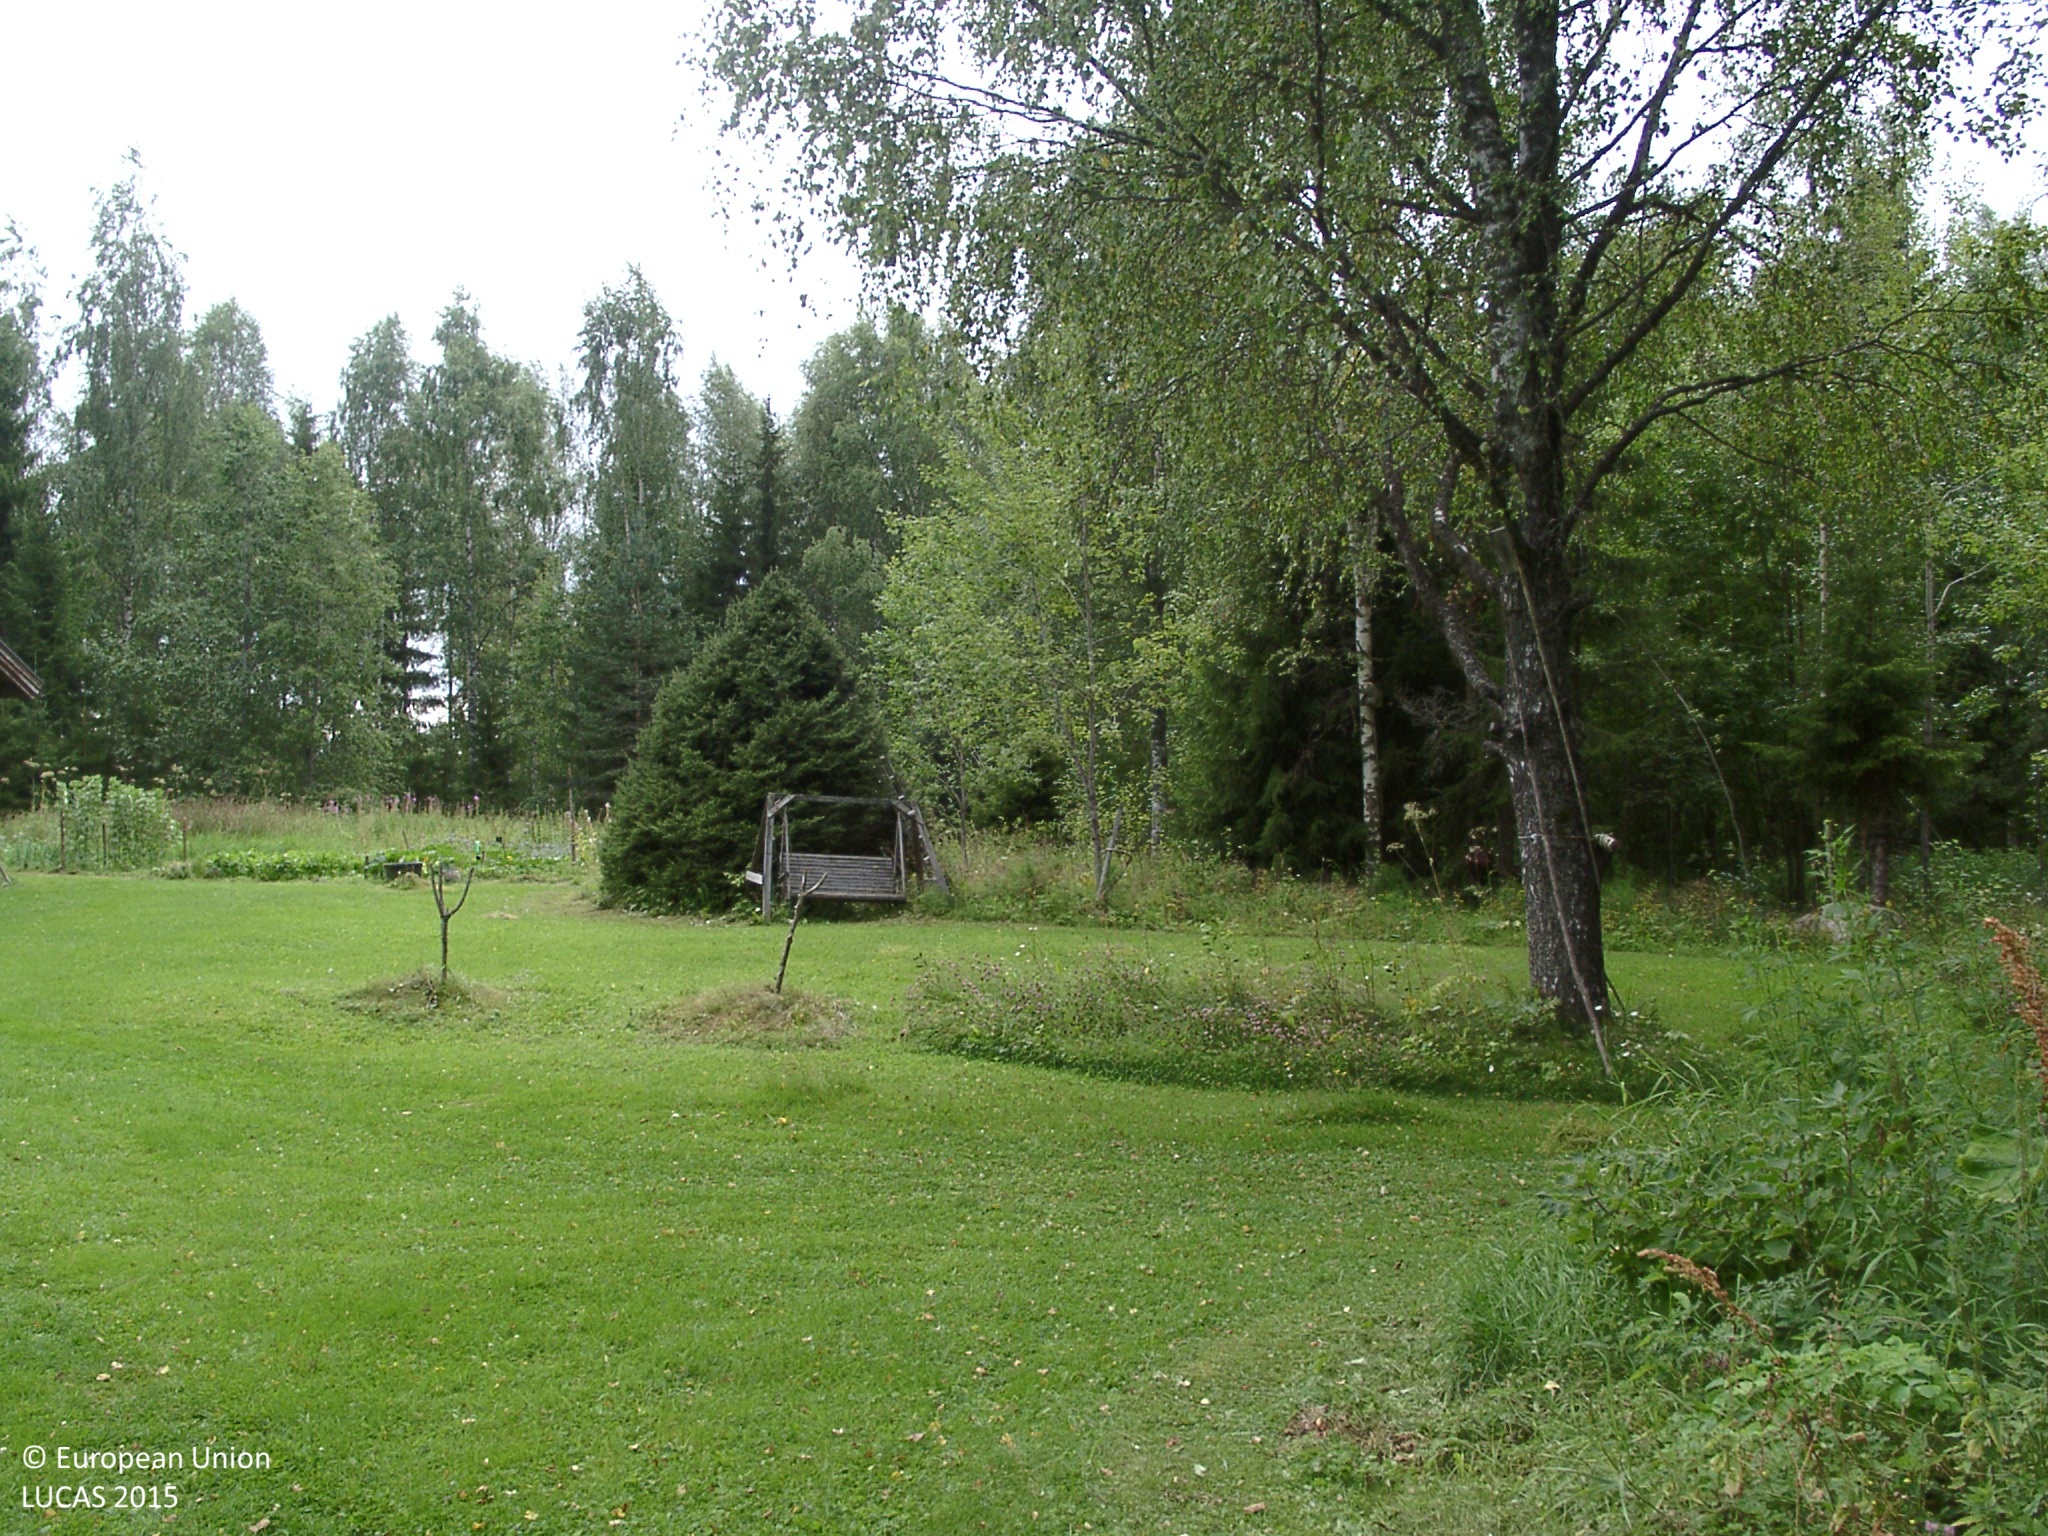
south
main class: Grassland
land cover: Grassland without tree/shrub cover
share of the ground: > 75 %
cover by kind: herbaceous plants 75 %, lichens and mosses 25 %
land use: Residential
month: August
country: FI
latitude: 62.4286
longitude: 25.5089
